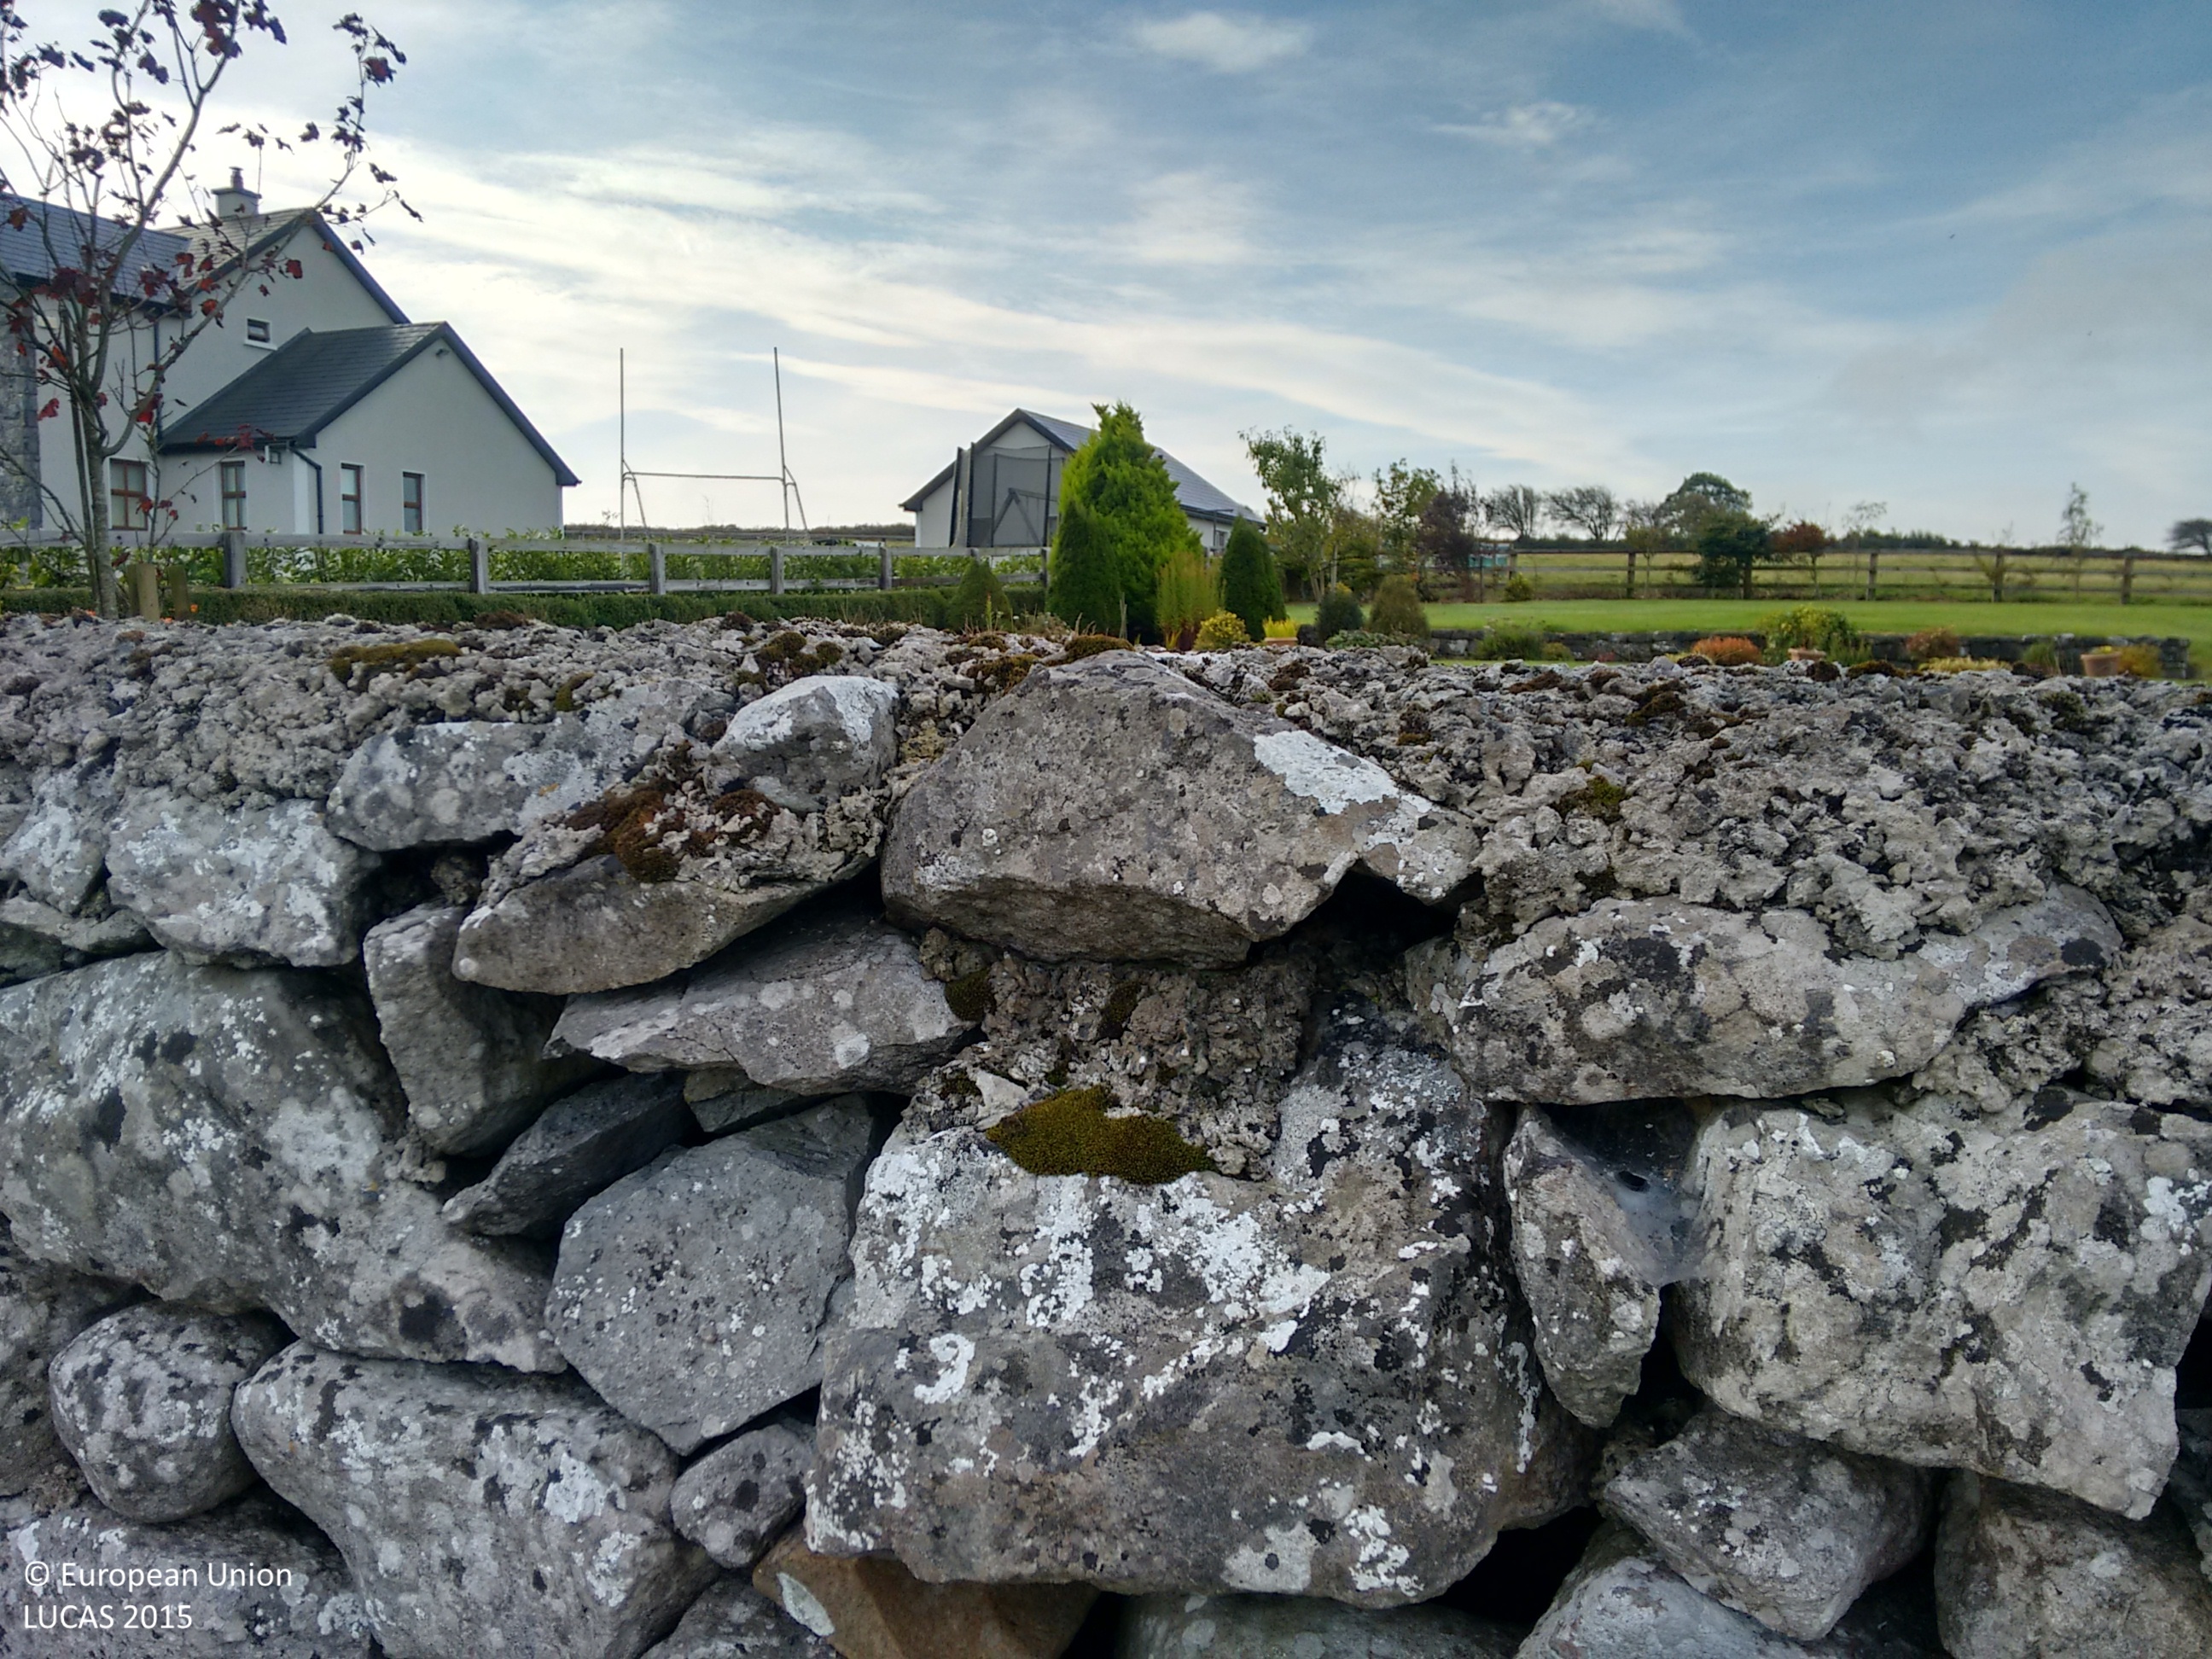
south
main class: Grassland
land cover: Grassland without tree/shrub cover
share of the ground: > 75 %
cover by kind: herbaceous plants 100 %
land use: Agriculture (excluding fallow land and kitchen gardens)
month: September
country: IE
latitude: 52.9890
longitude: -9.2148
